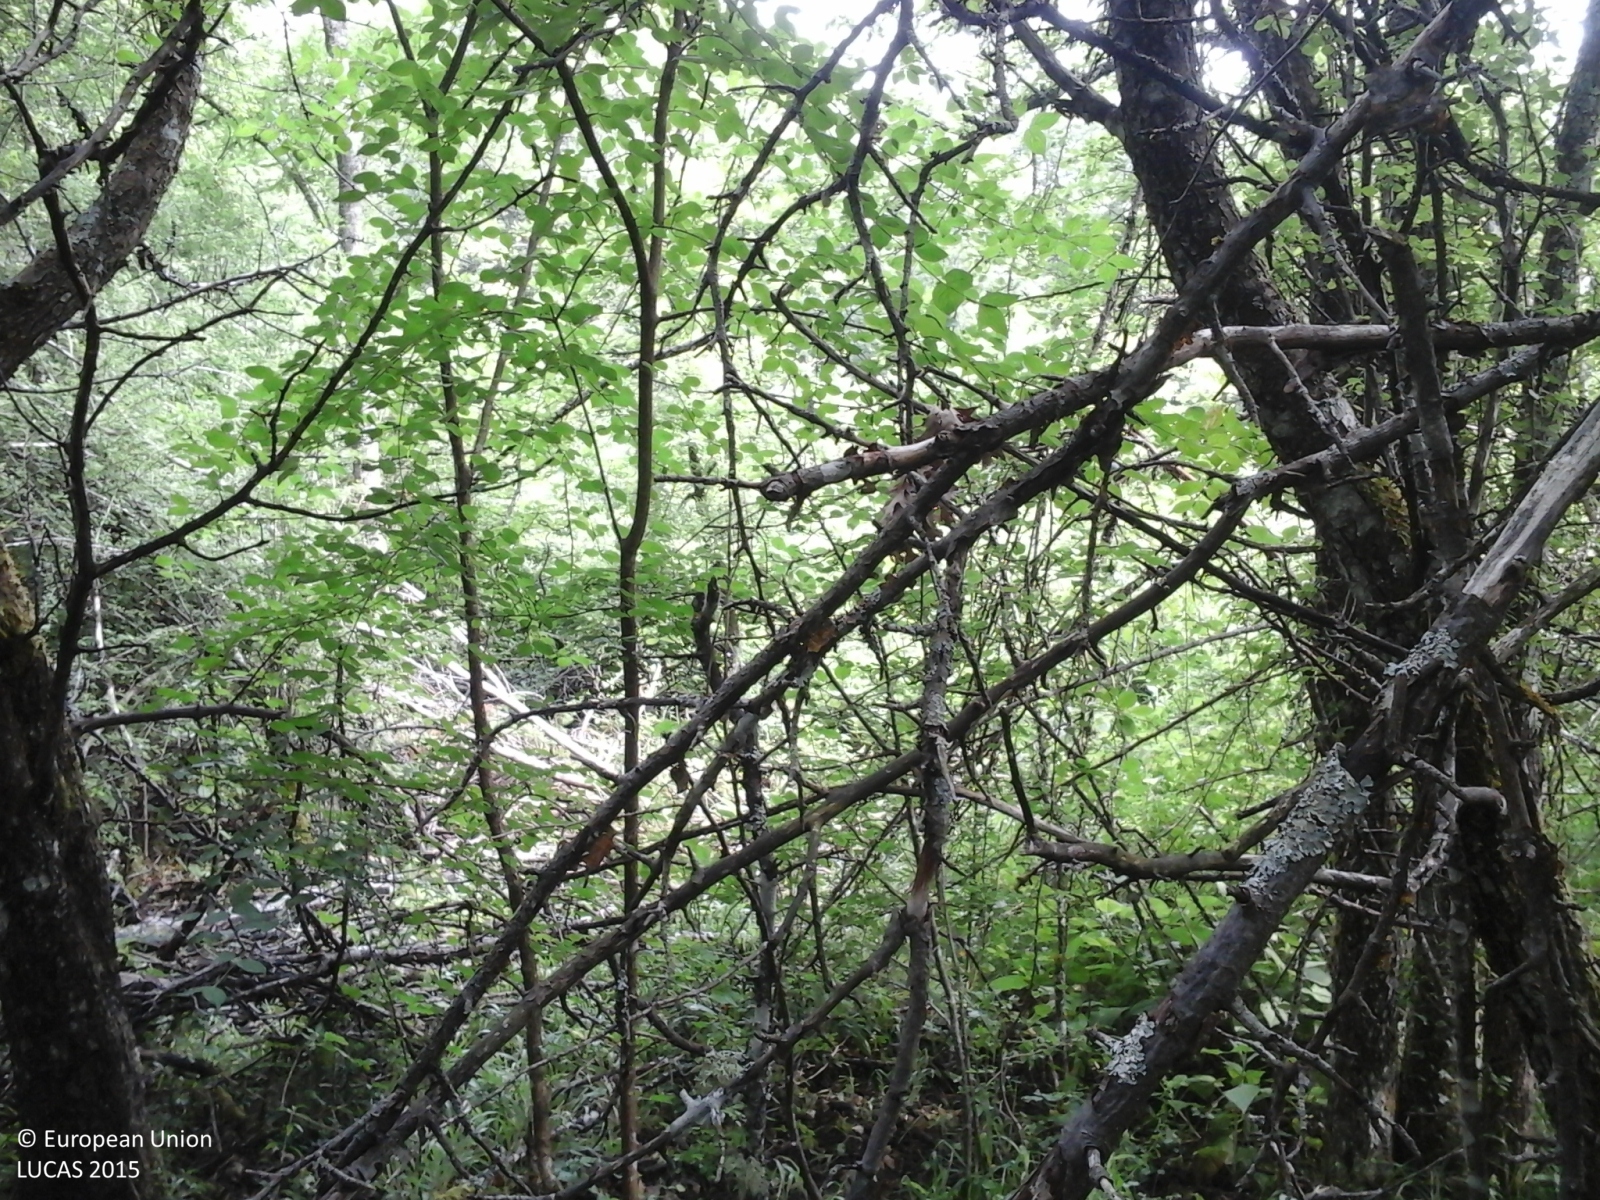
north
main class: Woodland
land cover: Broadleaved woodland
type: thermophilous deciduous forest
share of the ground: > 75 %
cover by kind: broadleaved forest trees 100 %
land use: Forestry
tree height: > 5 m
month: June
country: IT
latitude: 44.6562
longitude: 9.5596
